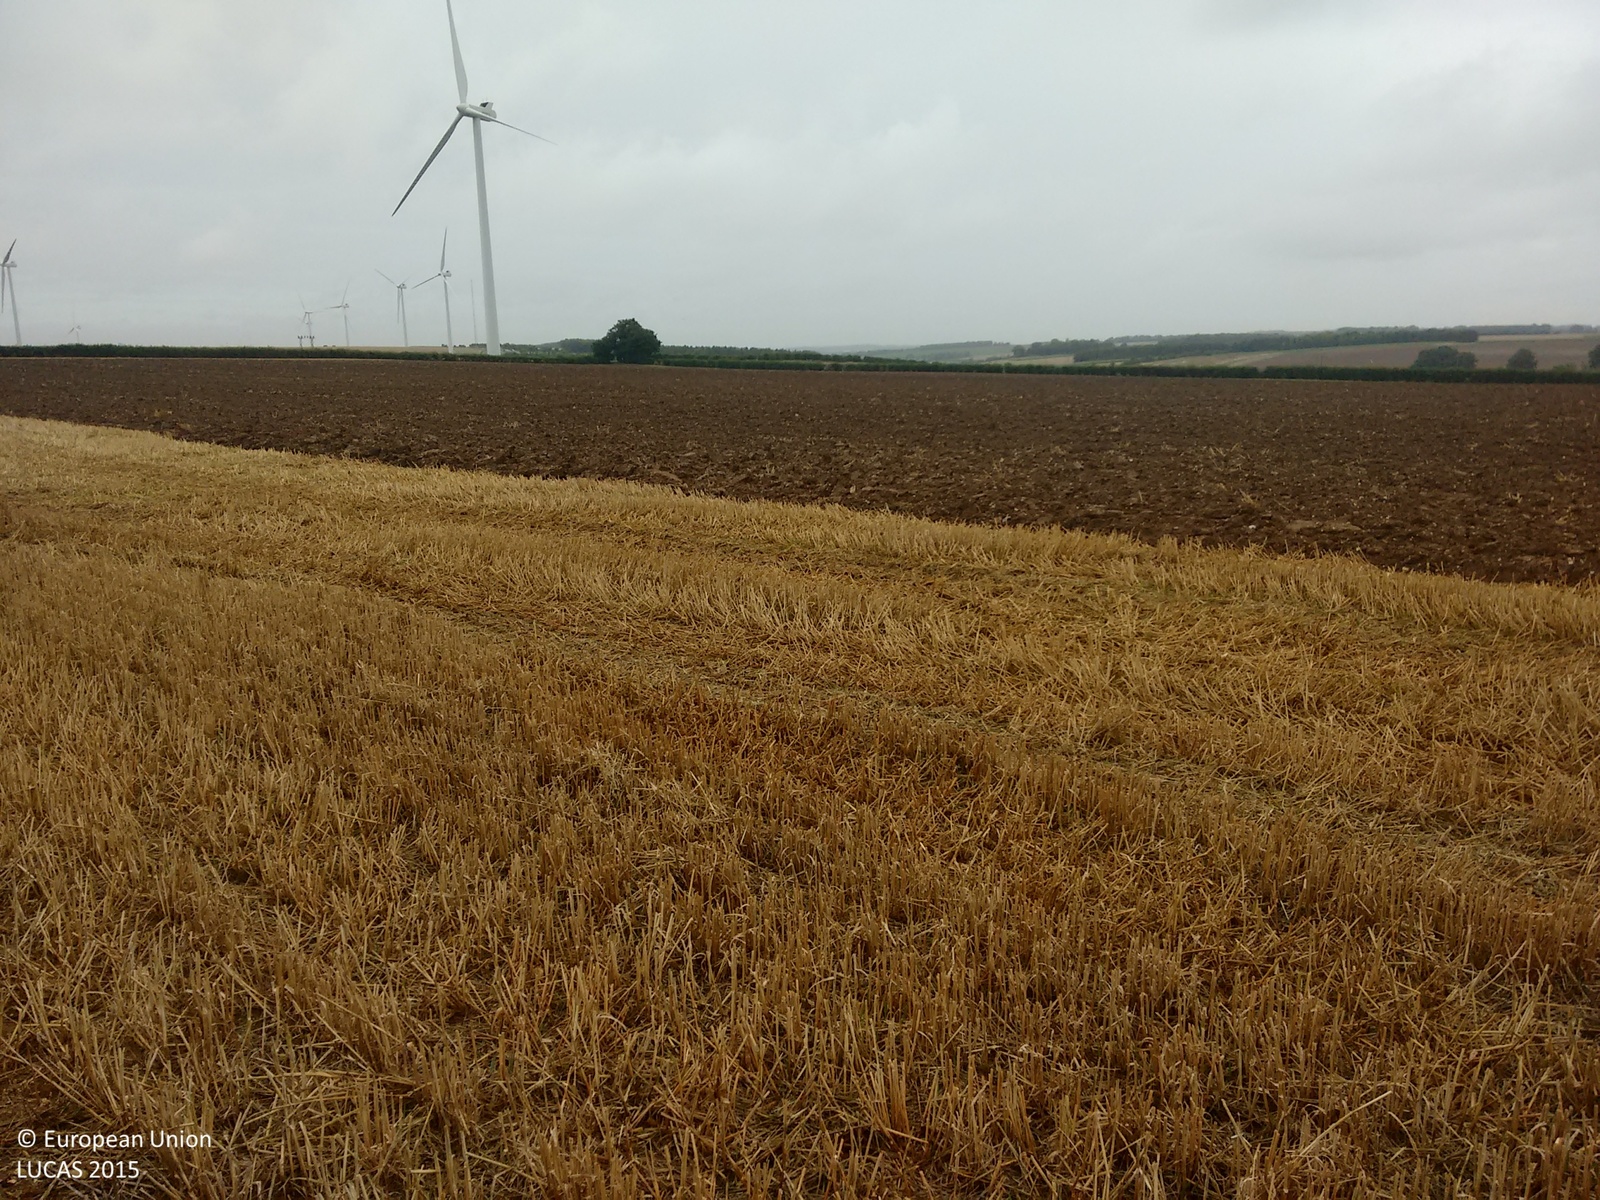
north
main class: Cropland
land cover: Common wheat
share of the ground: > 75 %
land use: Agriculture (excluding fallow land and kitchen gardens)
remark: Harvested field
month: August
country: GB
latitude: 52.1433
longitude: 0.3115
